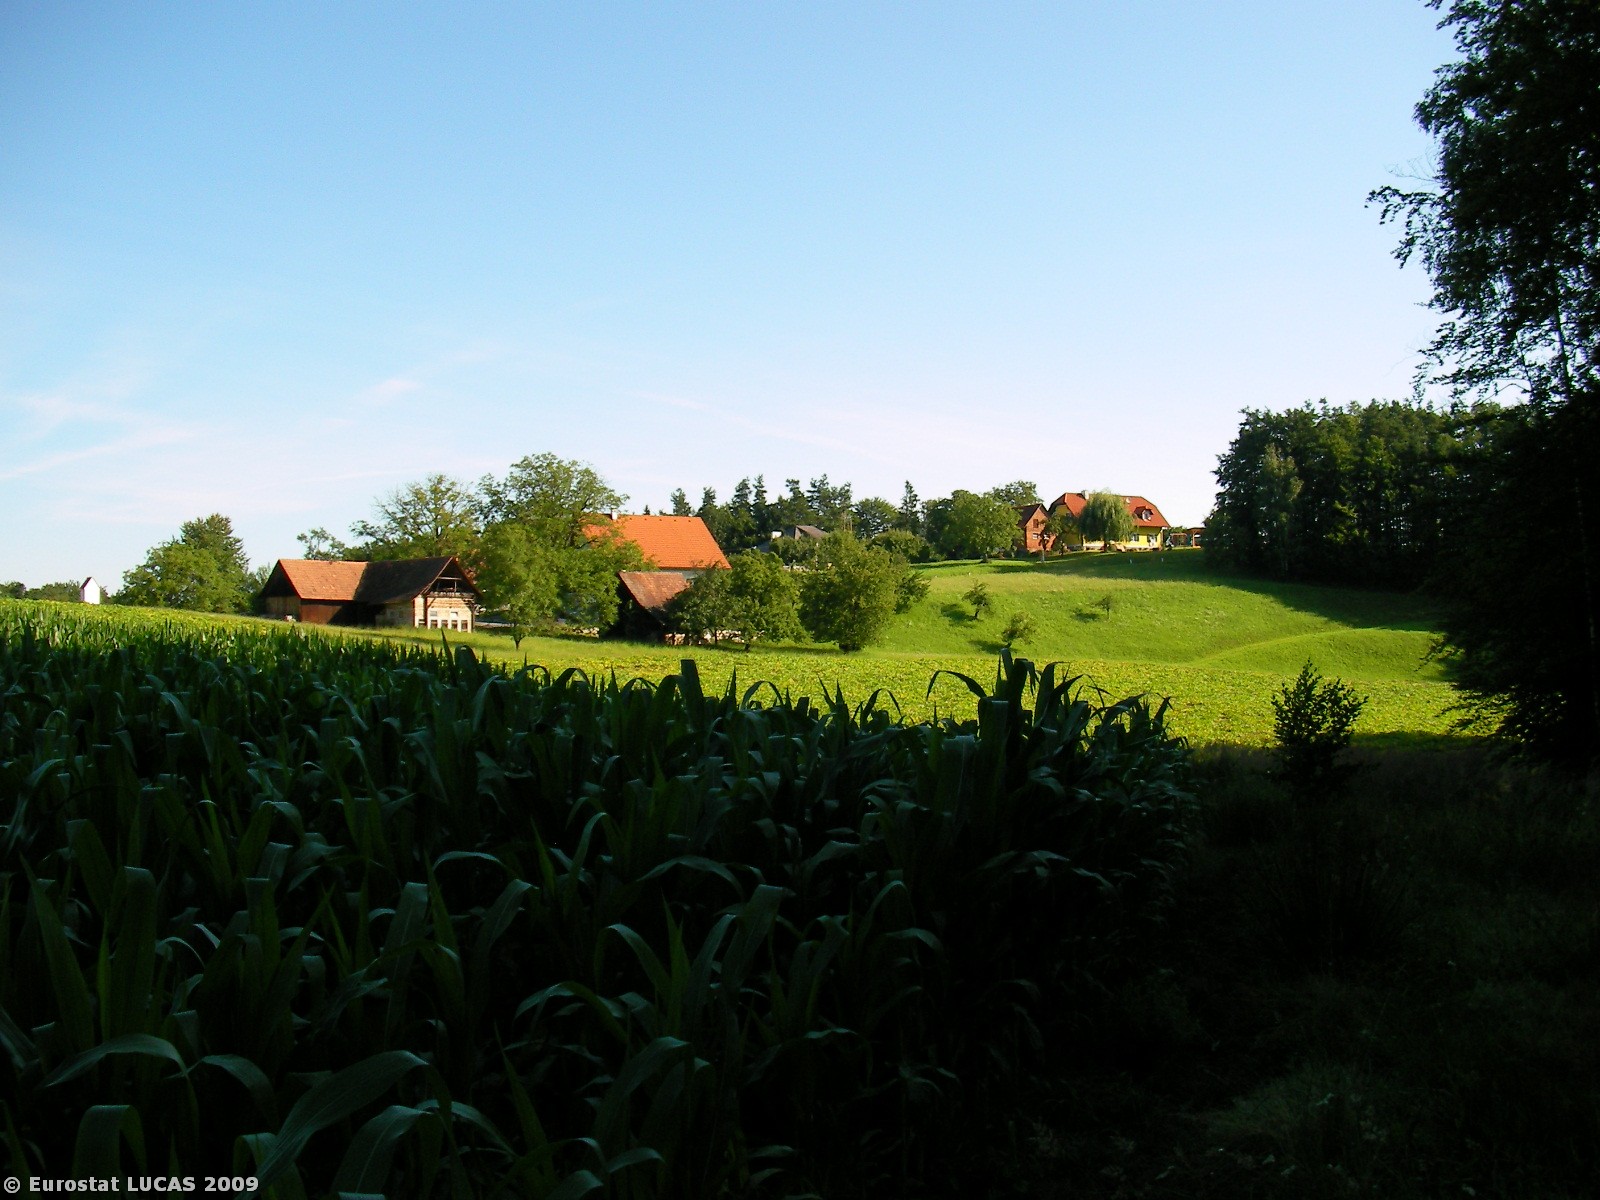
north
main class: Cropland
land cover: Maize
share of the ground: > 75 %
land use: Agriculture (excluding fallow land and kitchen gardens)
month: July
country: AT
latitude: 46.9565
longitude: 15.7163
